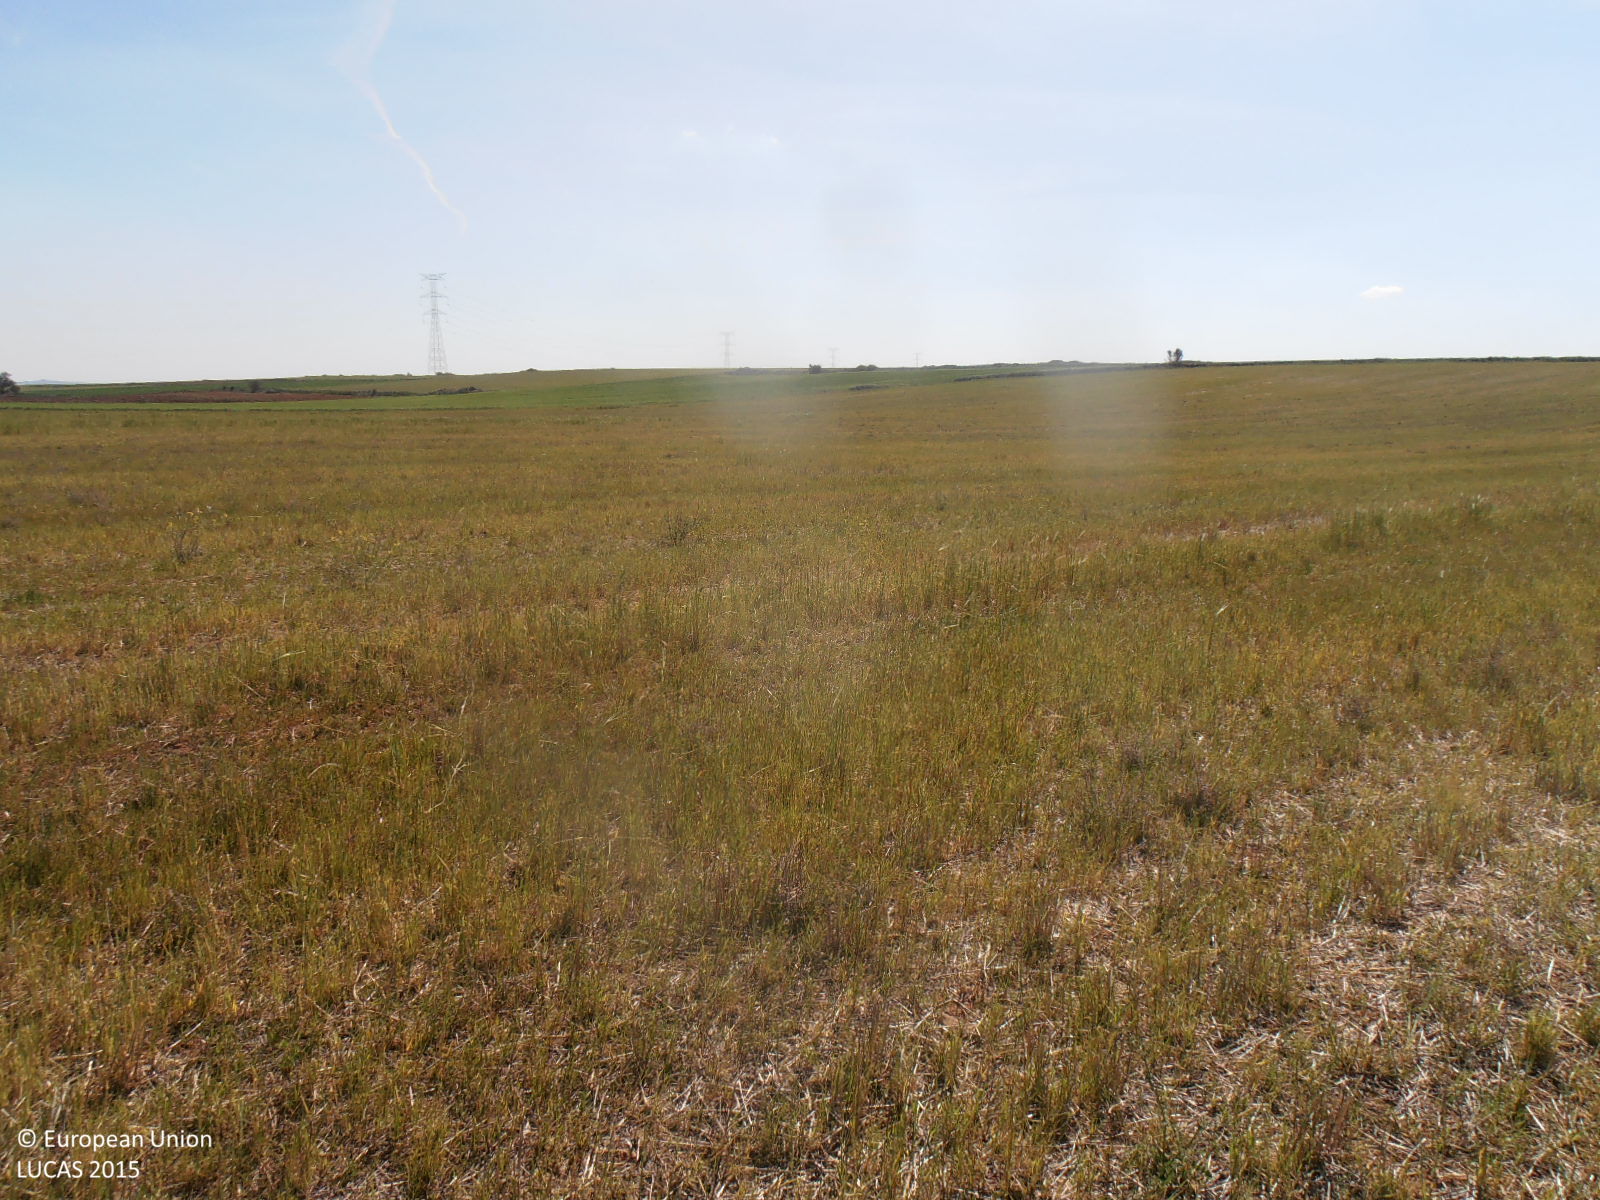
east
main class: Grassland
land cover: Spontaneously vegetated surfaces
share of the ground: > 75 %
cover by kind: herbaceous plants 100 %
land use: Agriculture (excluding fallow land and kitchen gardens)
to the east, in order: Spontaneously vegetated surfaces; Grass margins; Barley
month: April
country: ES
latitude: 41.1994
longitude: -0.9769
